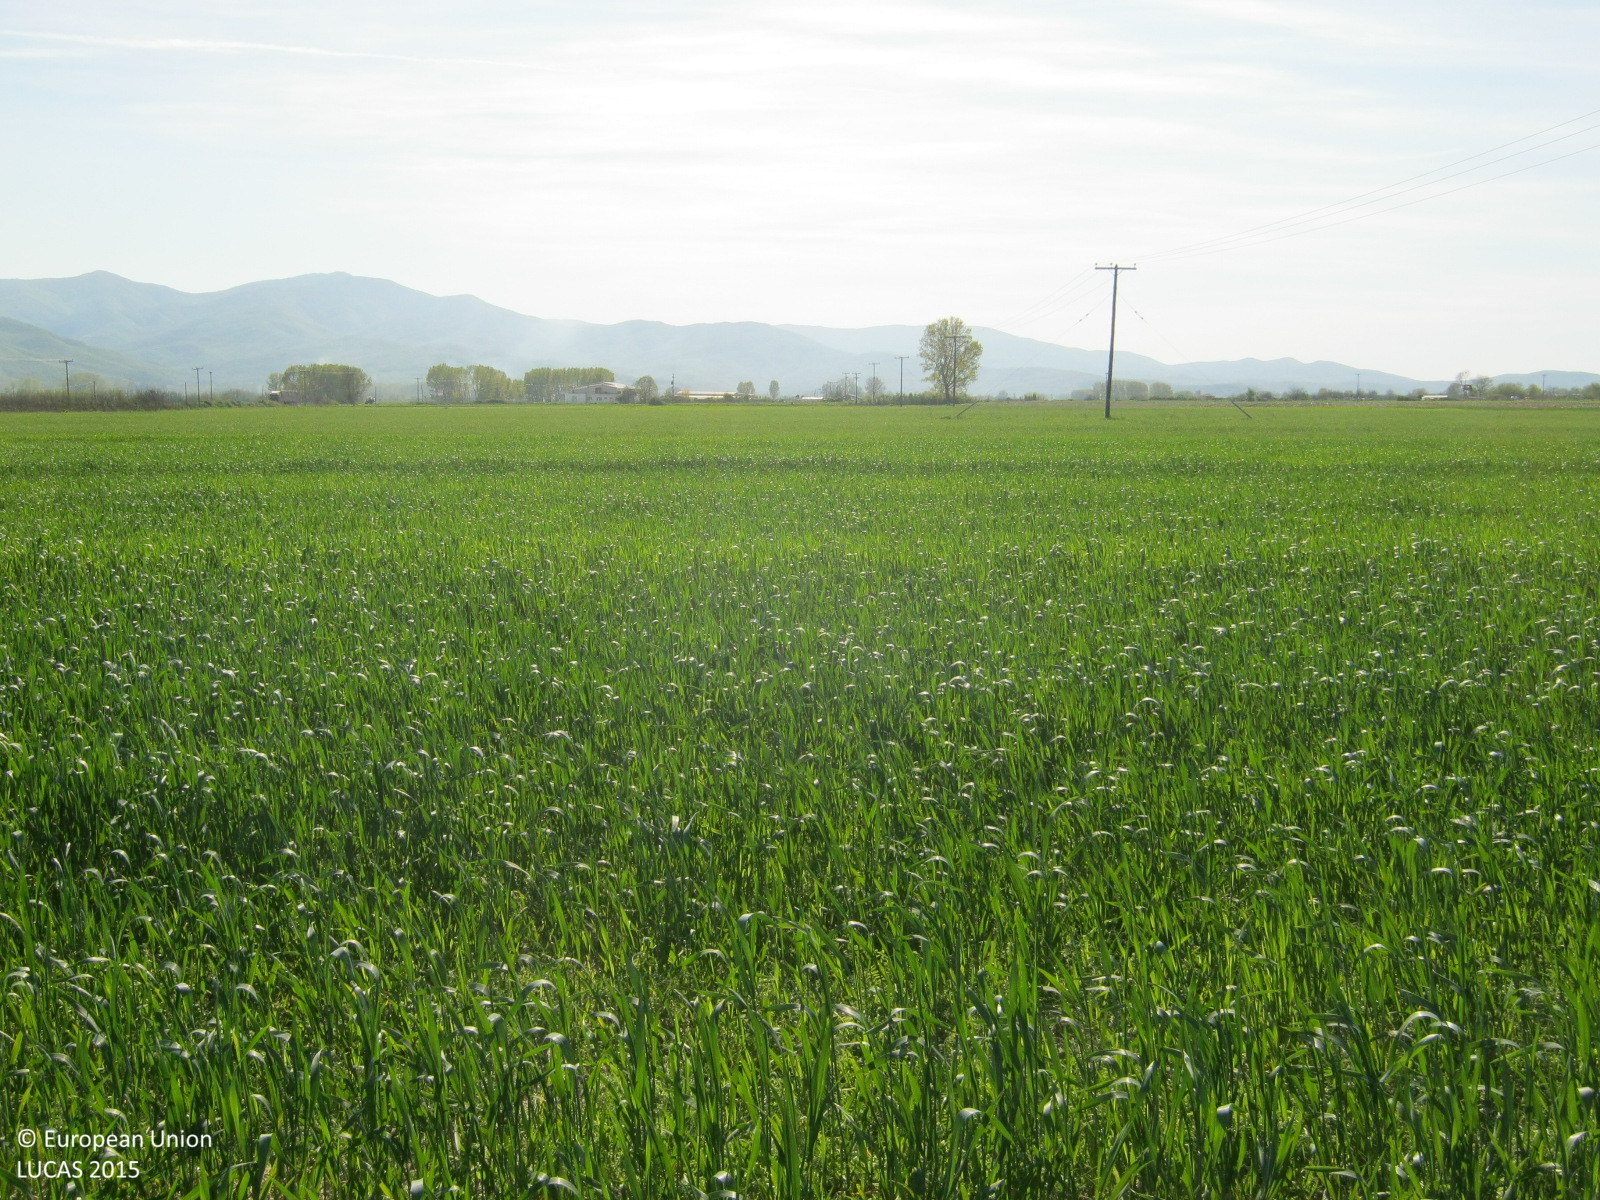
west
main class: Cropland
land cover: Common wheat
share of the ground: > 75 %
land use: Agriculture (excluding fallow land and kitchen gardens)
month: April
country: GR
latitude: 41.2561
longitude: 23.0603
